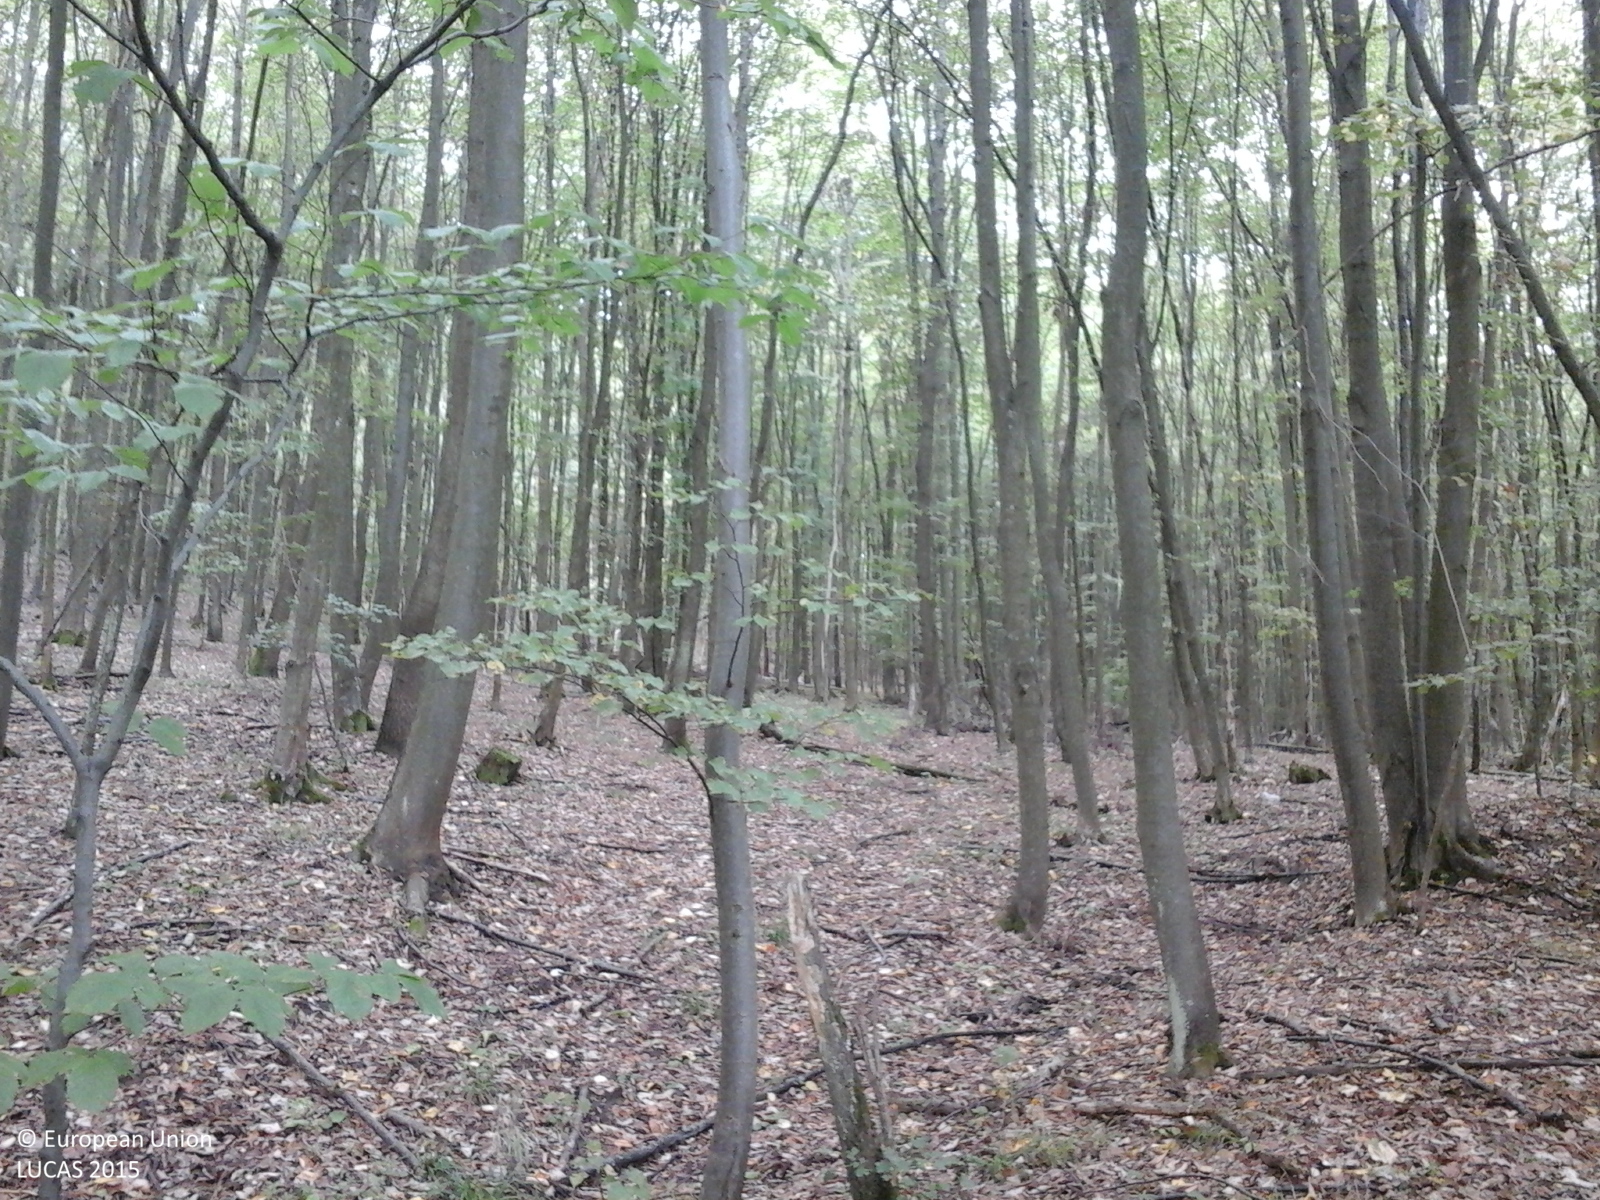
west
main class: Woodland
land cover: Broadleaved woodland
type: beech forest
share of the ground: > 75 %
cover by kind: broadleaved forest trees 100 %
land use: Forestry
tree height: > 5 m
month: September
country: RO
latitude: 45.9460
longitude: 21.9994
